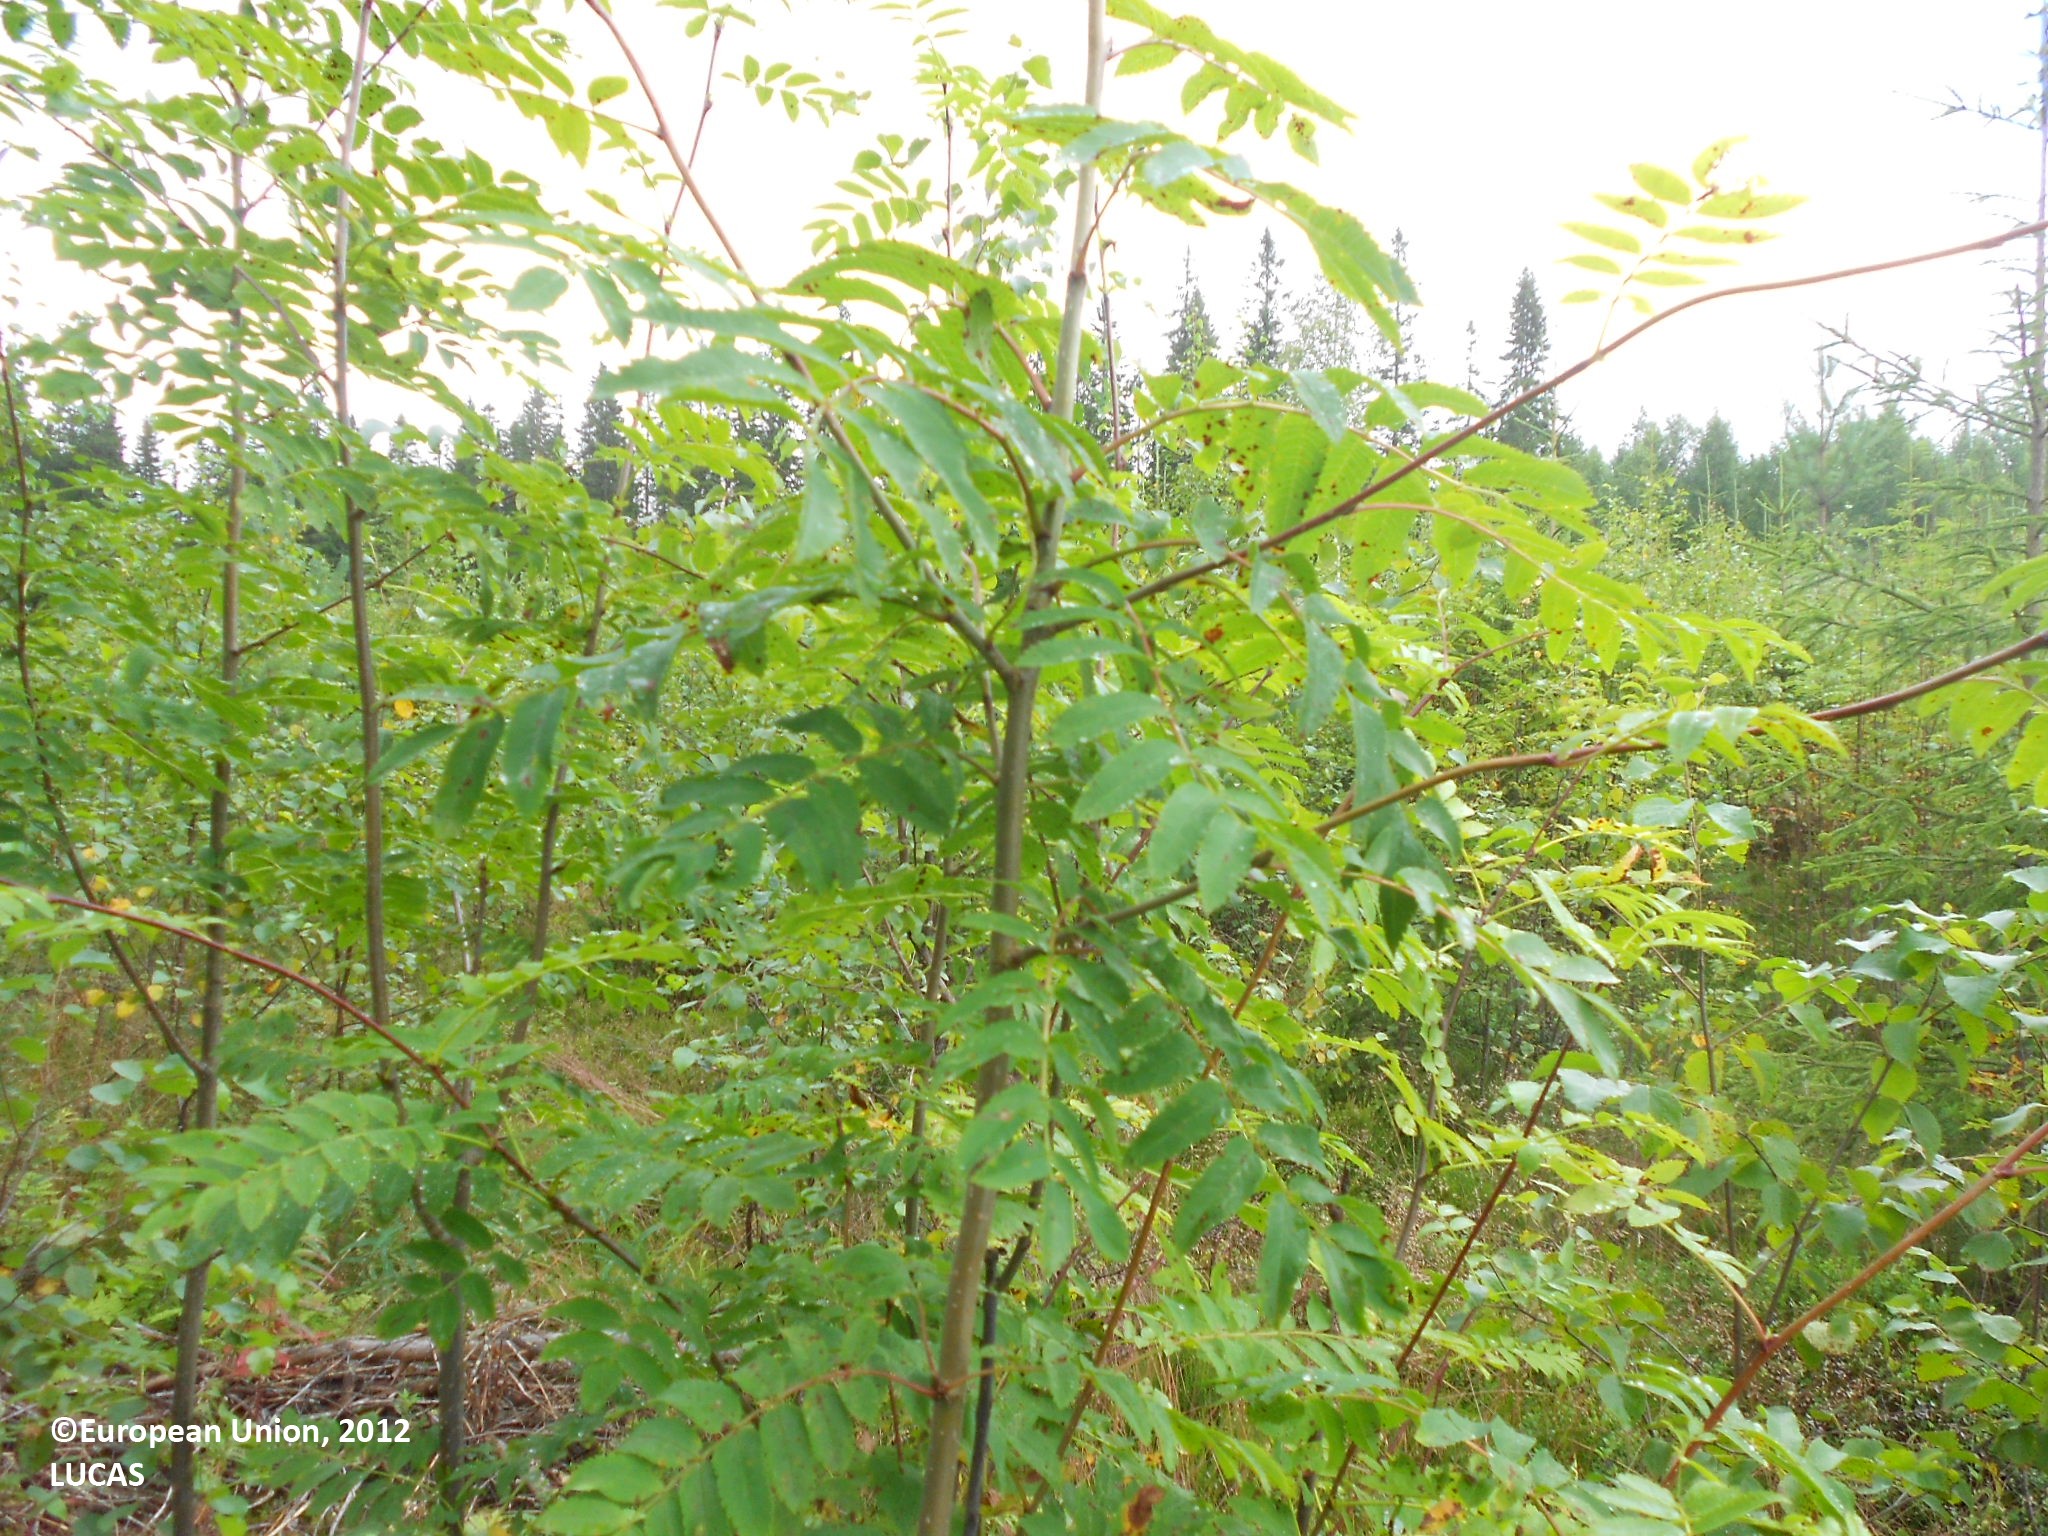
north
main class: Woodland
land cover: Spruce dominated mixed woodland
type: boreal forest
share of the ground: 50 - 75 %
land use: Forestry
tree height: < 5 m
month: August
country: FI
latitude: 63.3764
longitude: 28.7409
